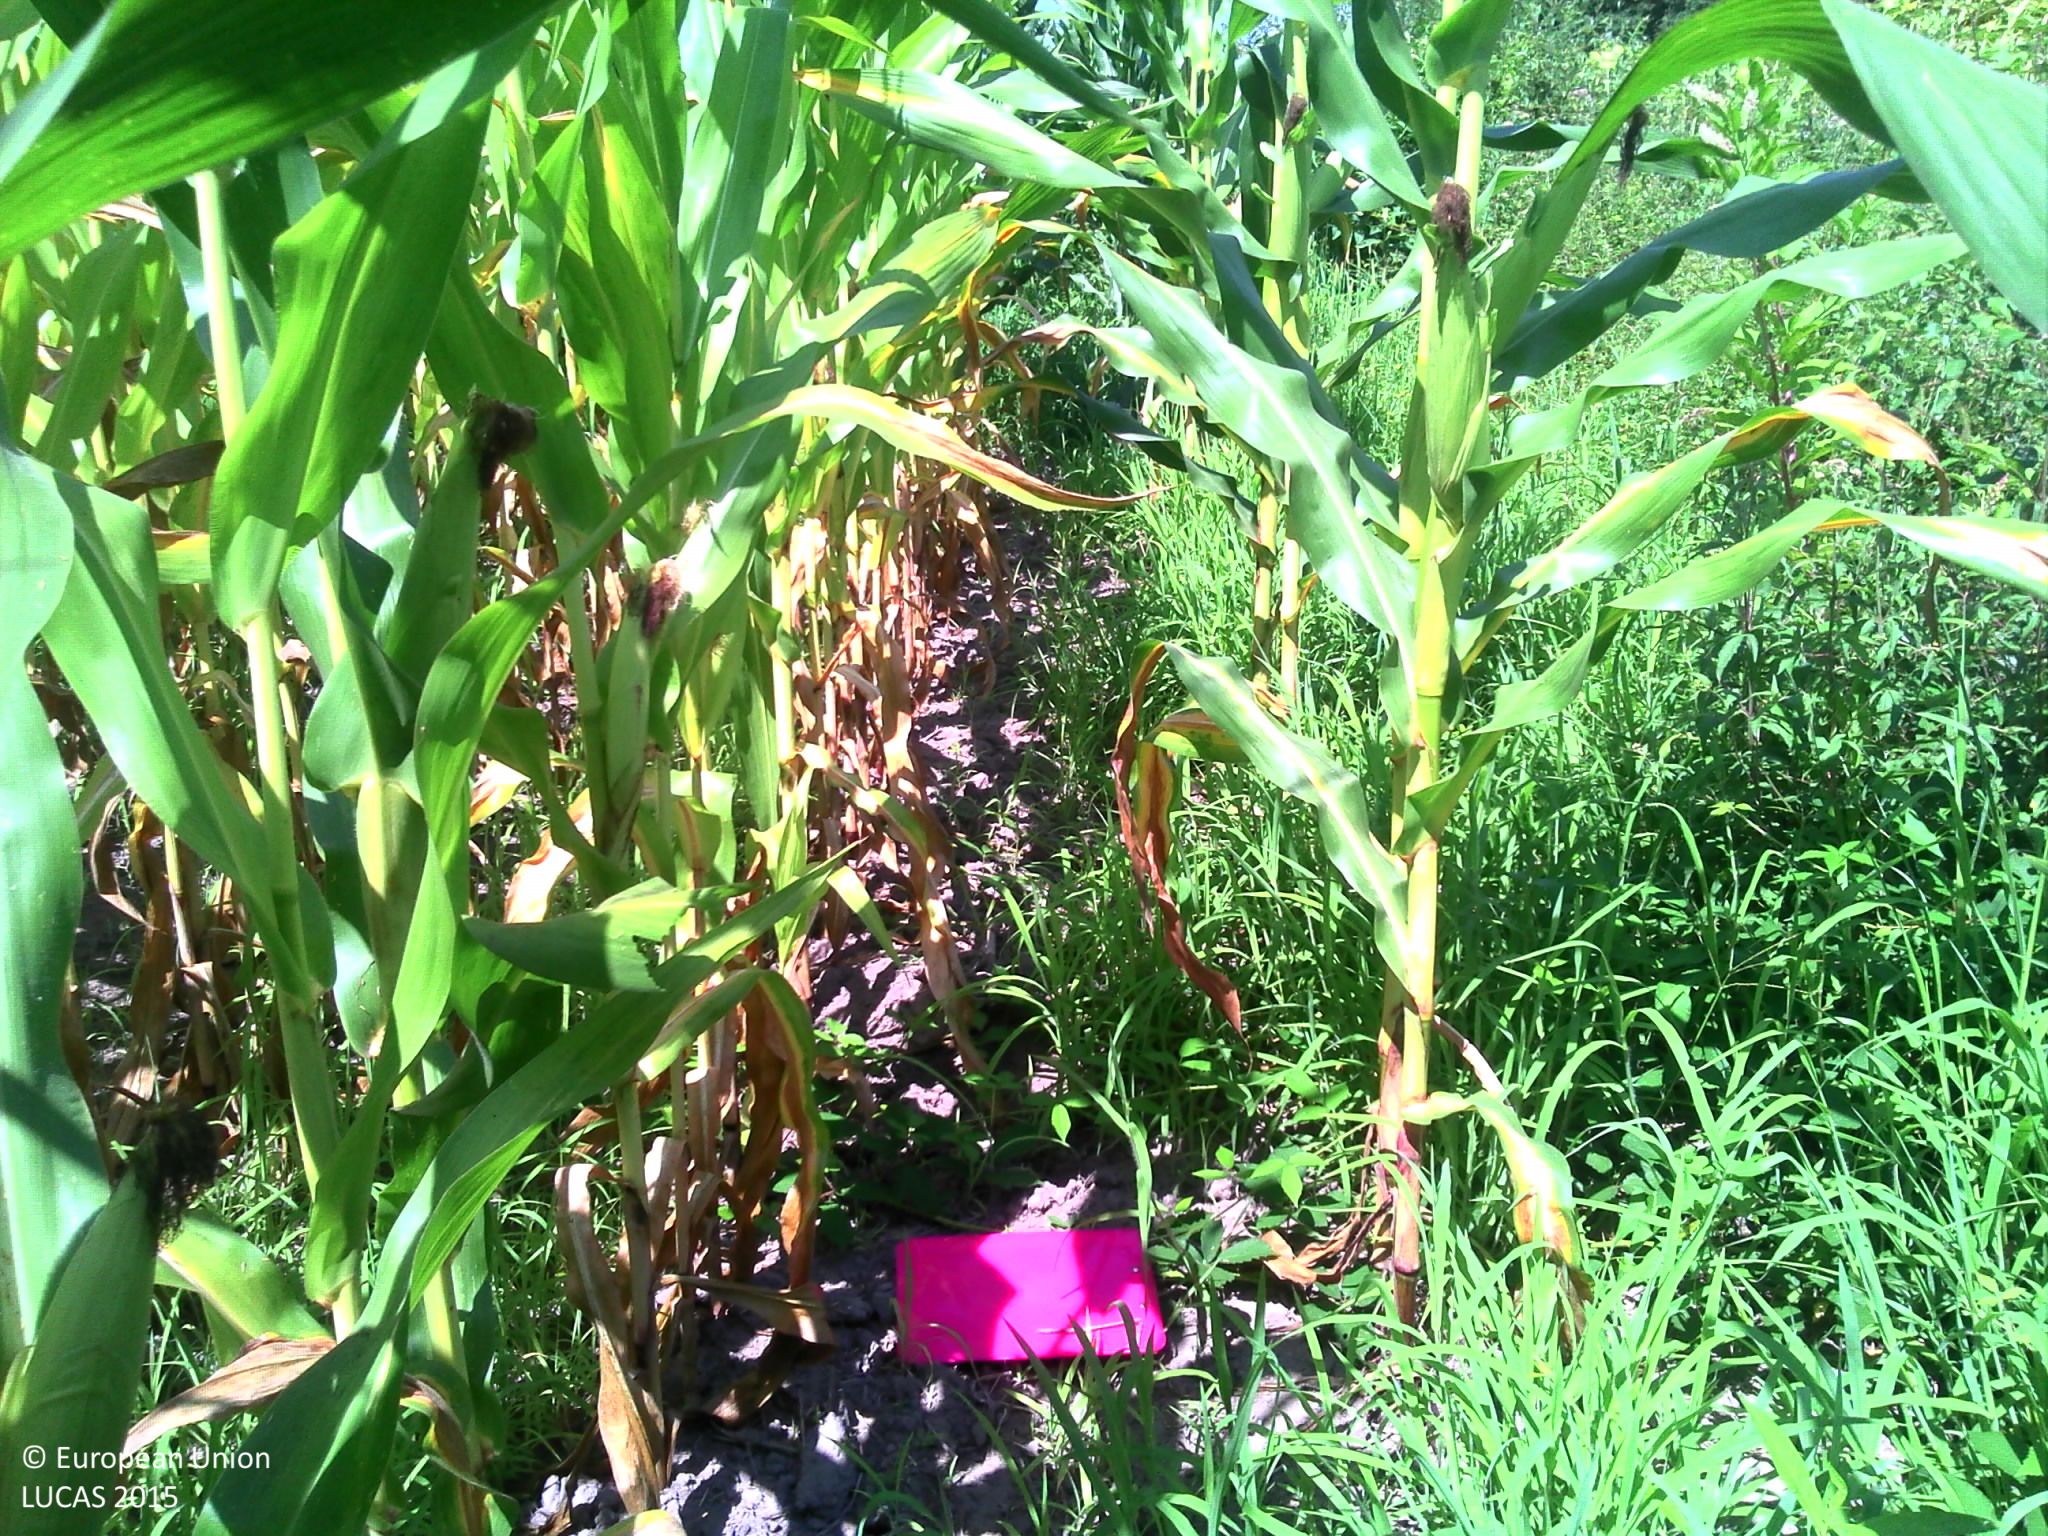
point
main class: Cropland
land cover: Maize
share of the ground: > 75 %
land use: Agriculture (excluding fallow land and kitchen gardens)
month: July
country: FR
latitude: 43.5662
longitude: -1.1461
